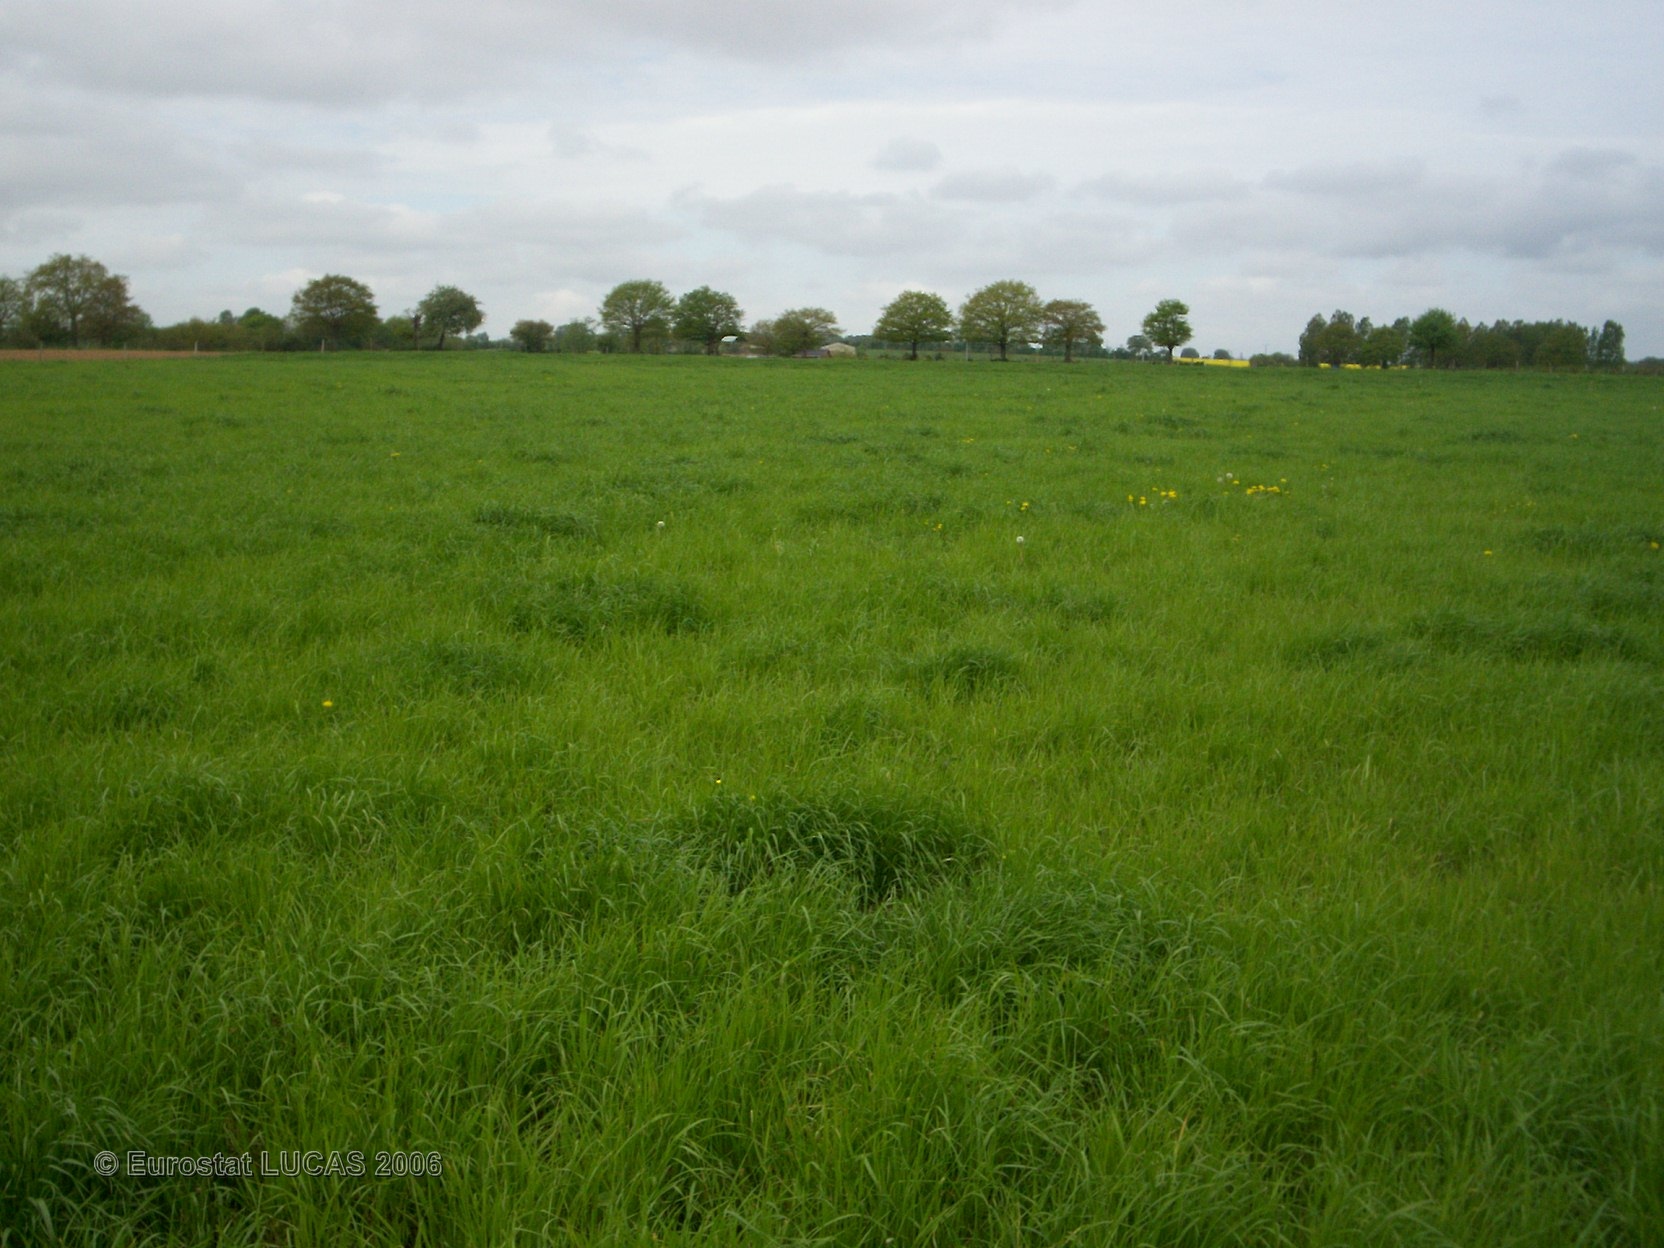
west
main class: Grassland
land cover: Grassland without tree/shrub cover
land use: Agriculture (excluding fallow land and kitchen gardens)
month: May
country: FR
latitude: 47.8248
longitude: -1.2752
